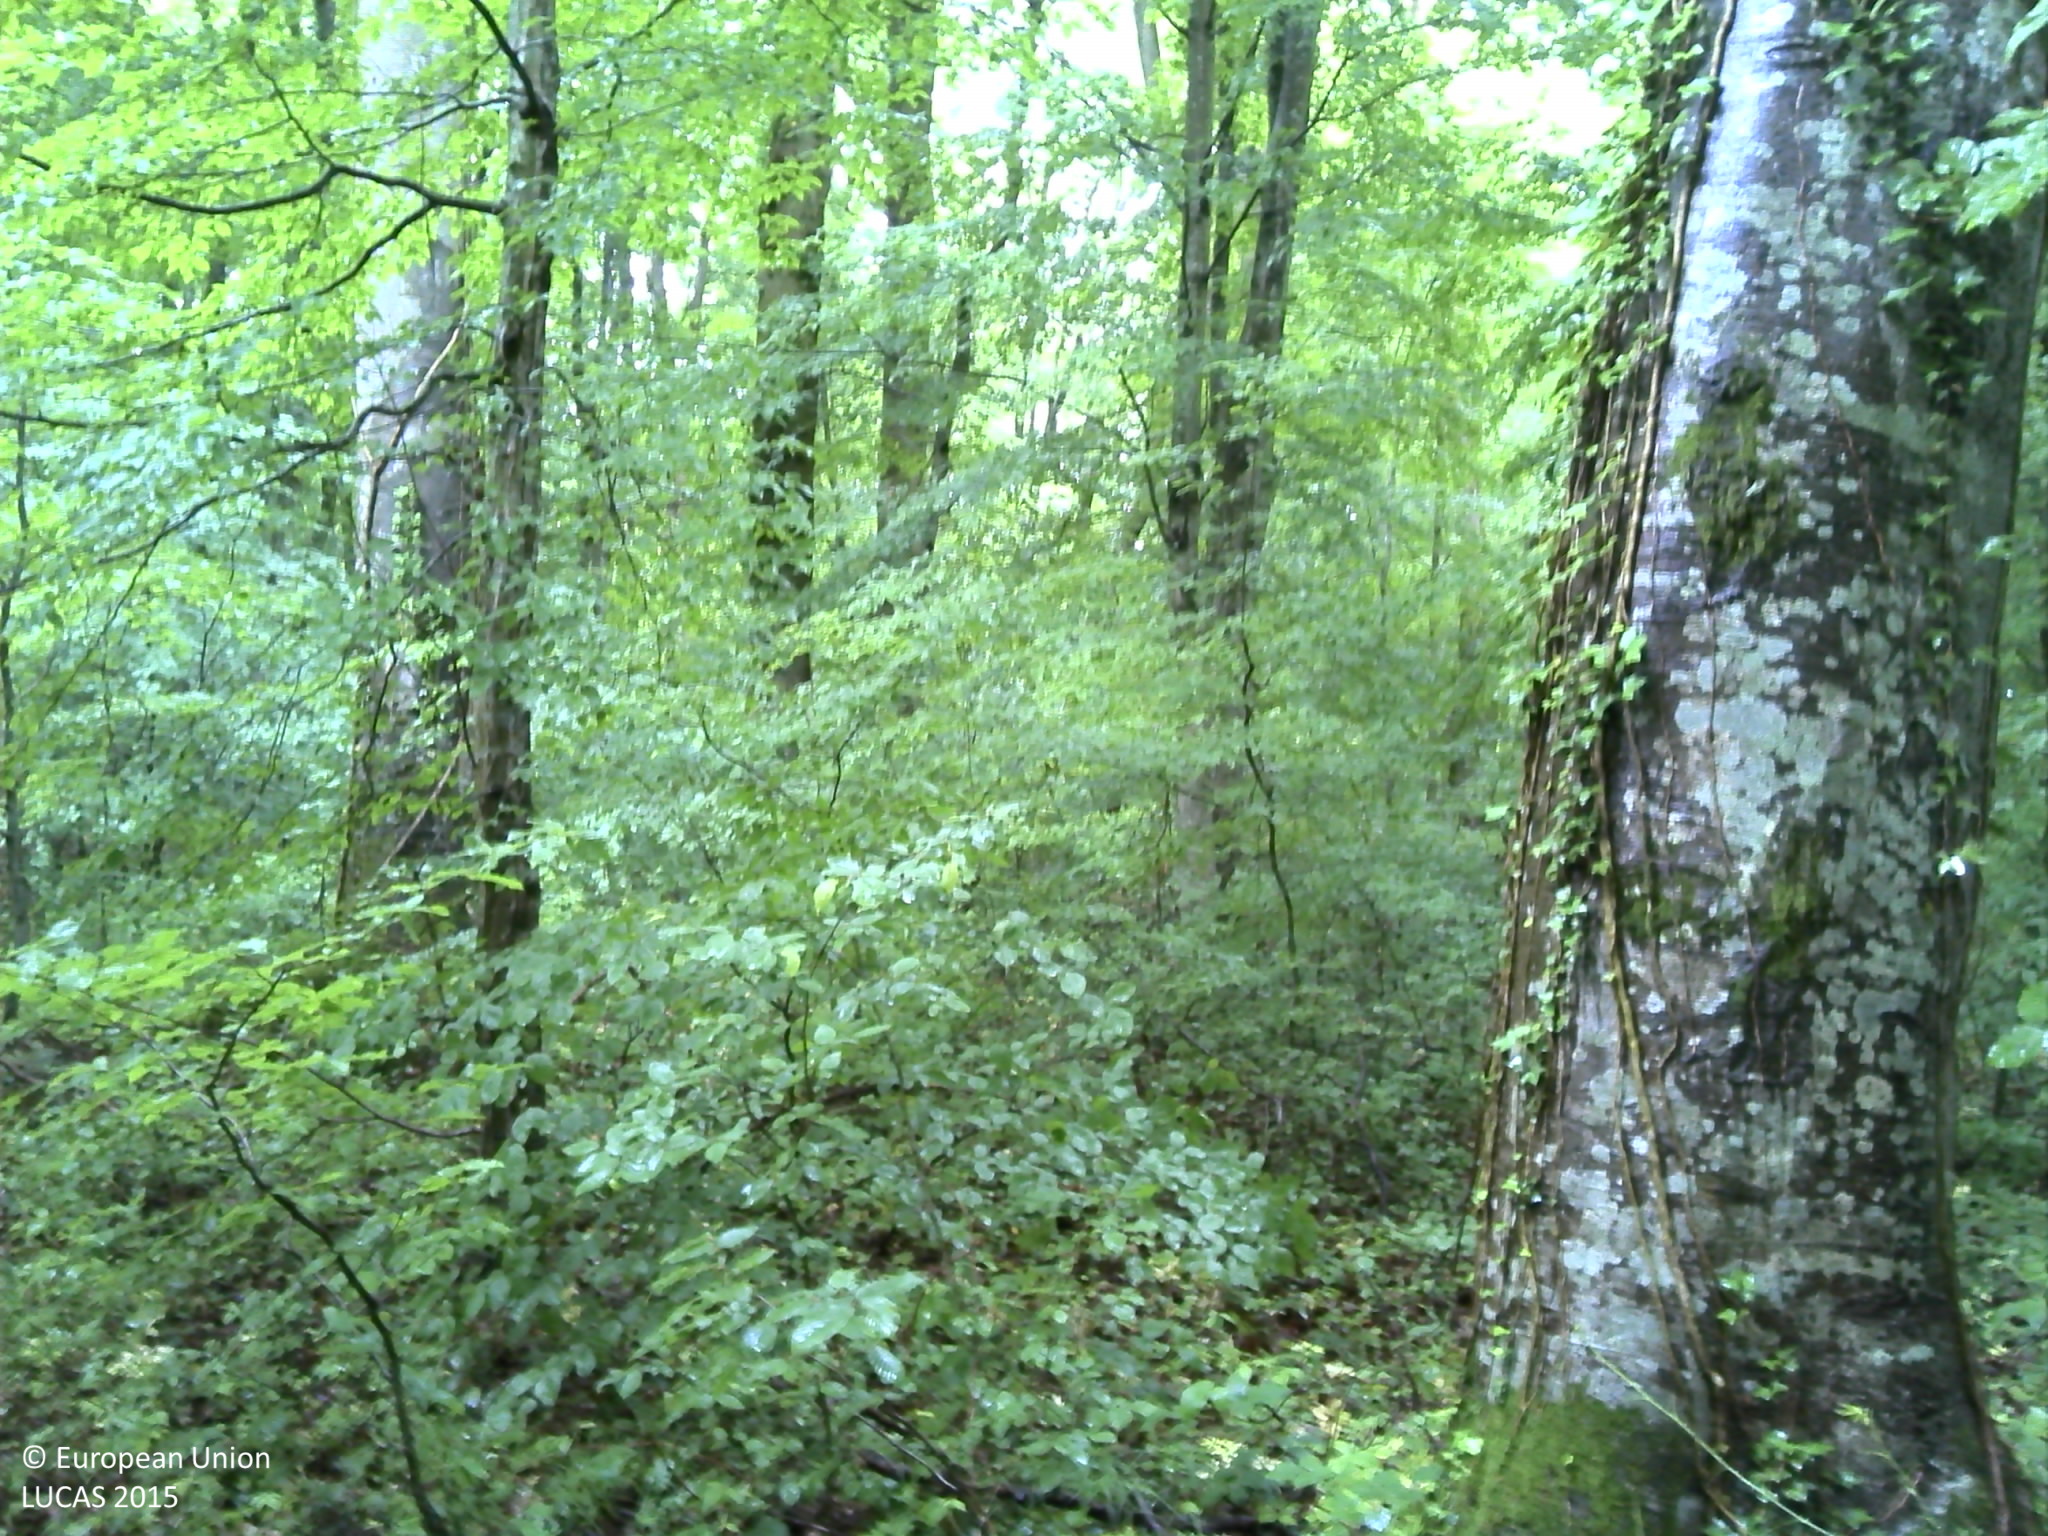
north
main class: Woodland
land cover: Broadleaved woodland
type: beech forest
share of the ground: > 75 %
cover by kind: broadleaved forest trees 95 %, herbaceous plants 5 %
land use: Forestry
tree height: > 5 m
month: June
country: FR
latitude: 48.9053
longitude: 6.4666
